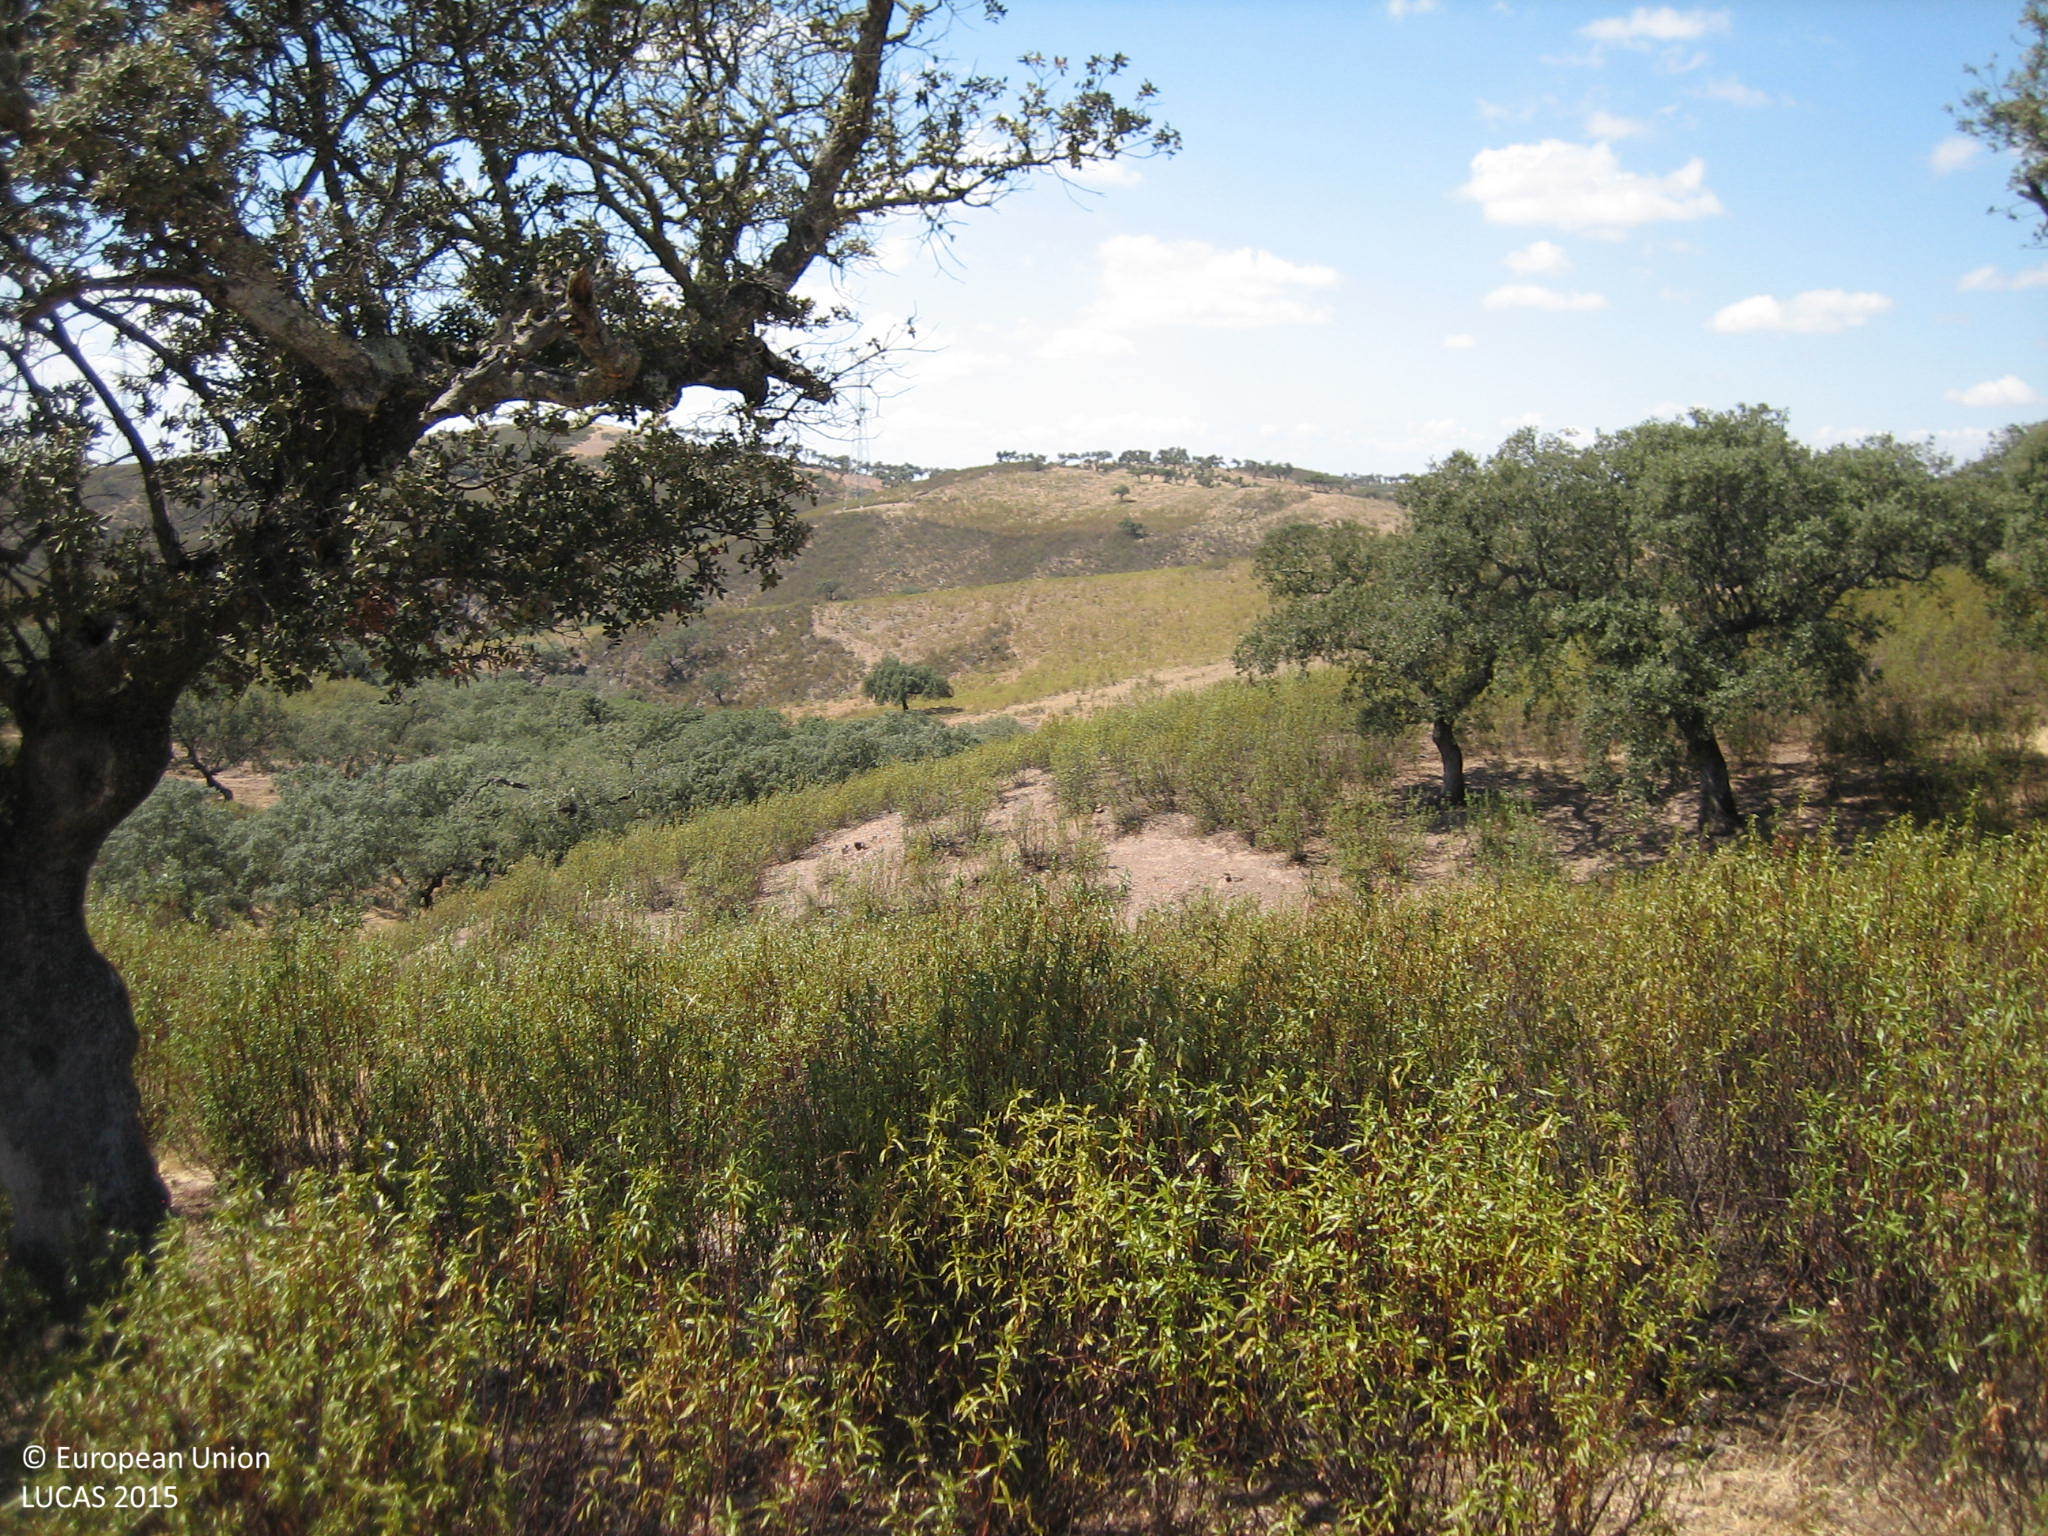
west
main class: Woodland
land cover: Broadleaved woodland
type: broadleaved evergreen forest
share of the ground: 10 - 25 %
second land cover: Grassland without tree/shrub cover
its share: 50 - 75 %
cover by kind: herbaceous plants 50 %, unconsolidated bare surface 25 %, broadleaved forest trees 20 %, shrubs 5 %
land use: Forestry
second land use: Agriculture (excluding fallow land and kitchen gardens)
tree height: > 5 m
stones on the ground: < 10 %
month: September
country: ES
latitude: 38.2023
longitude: -7.0861
